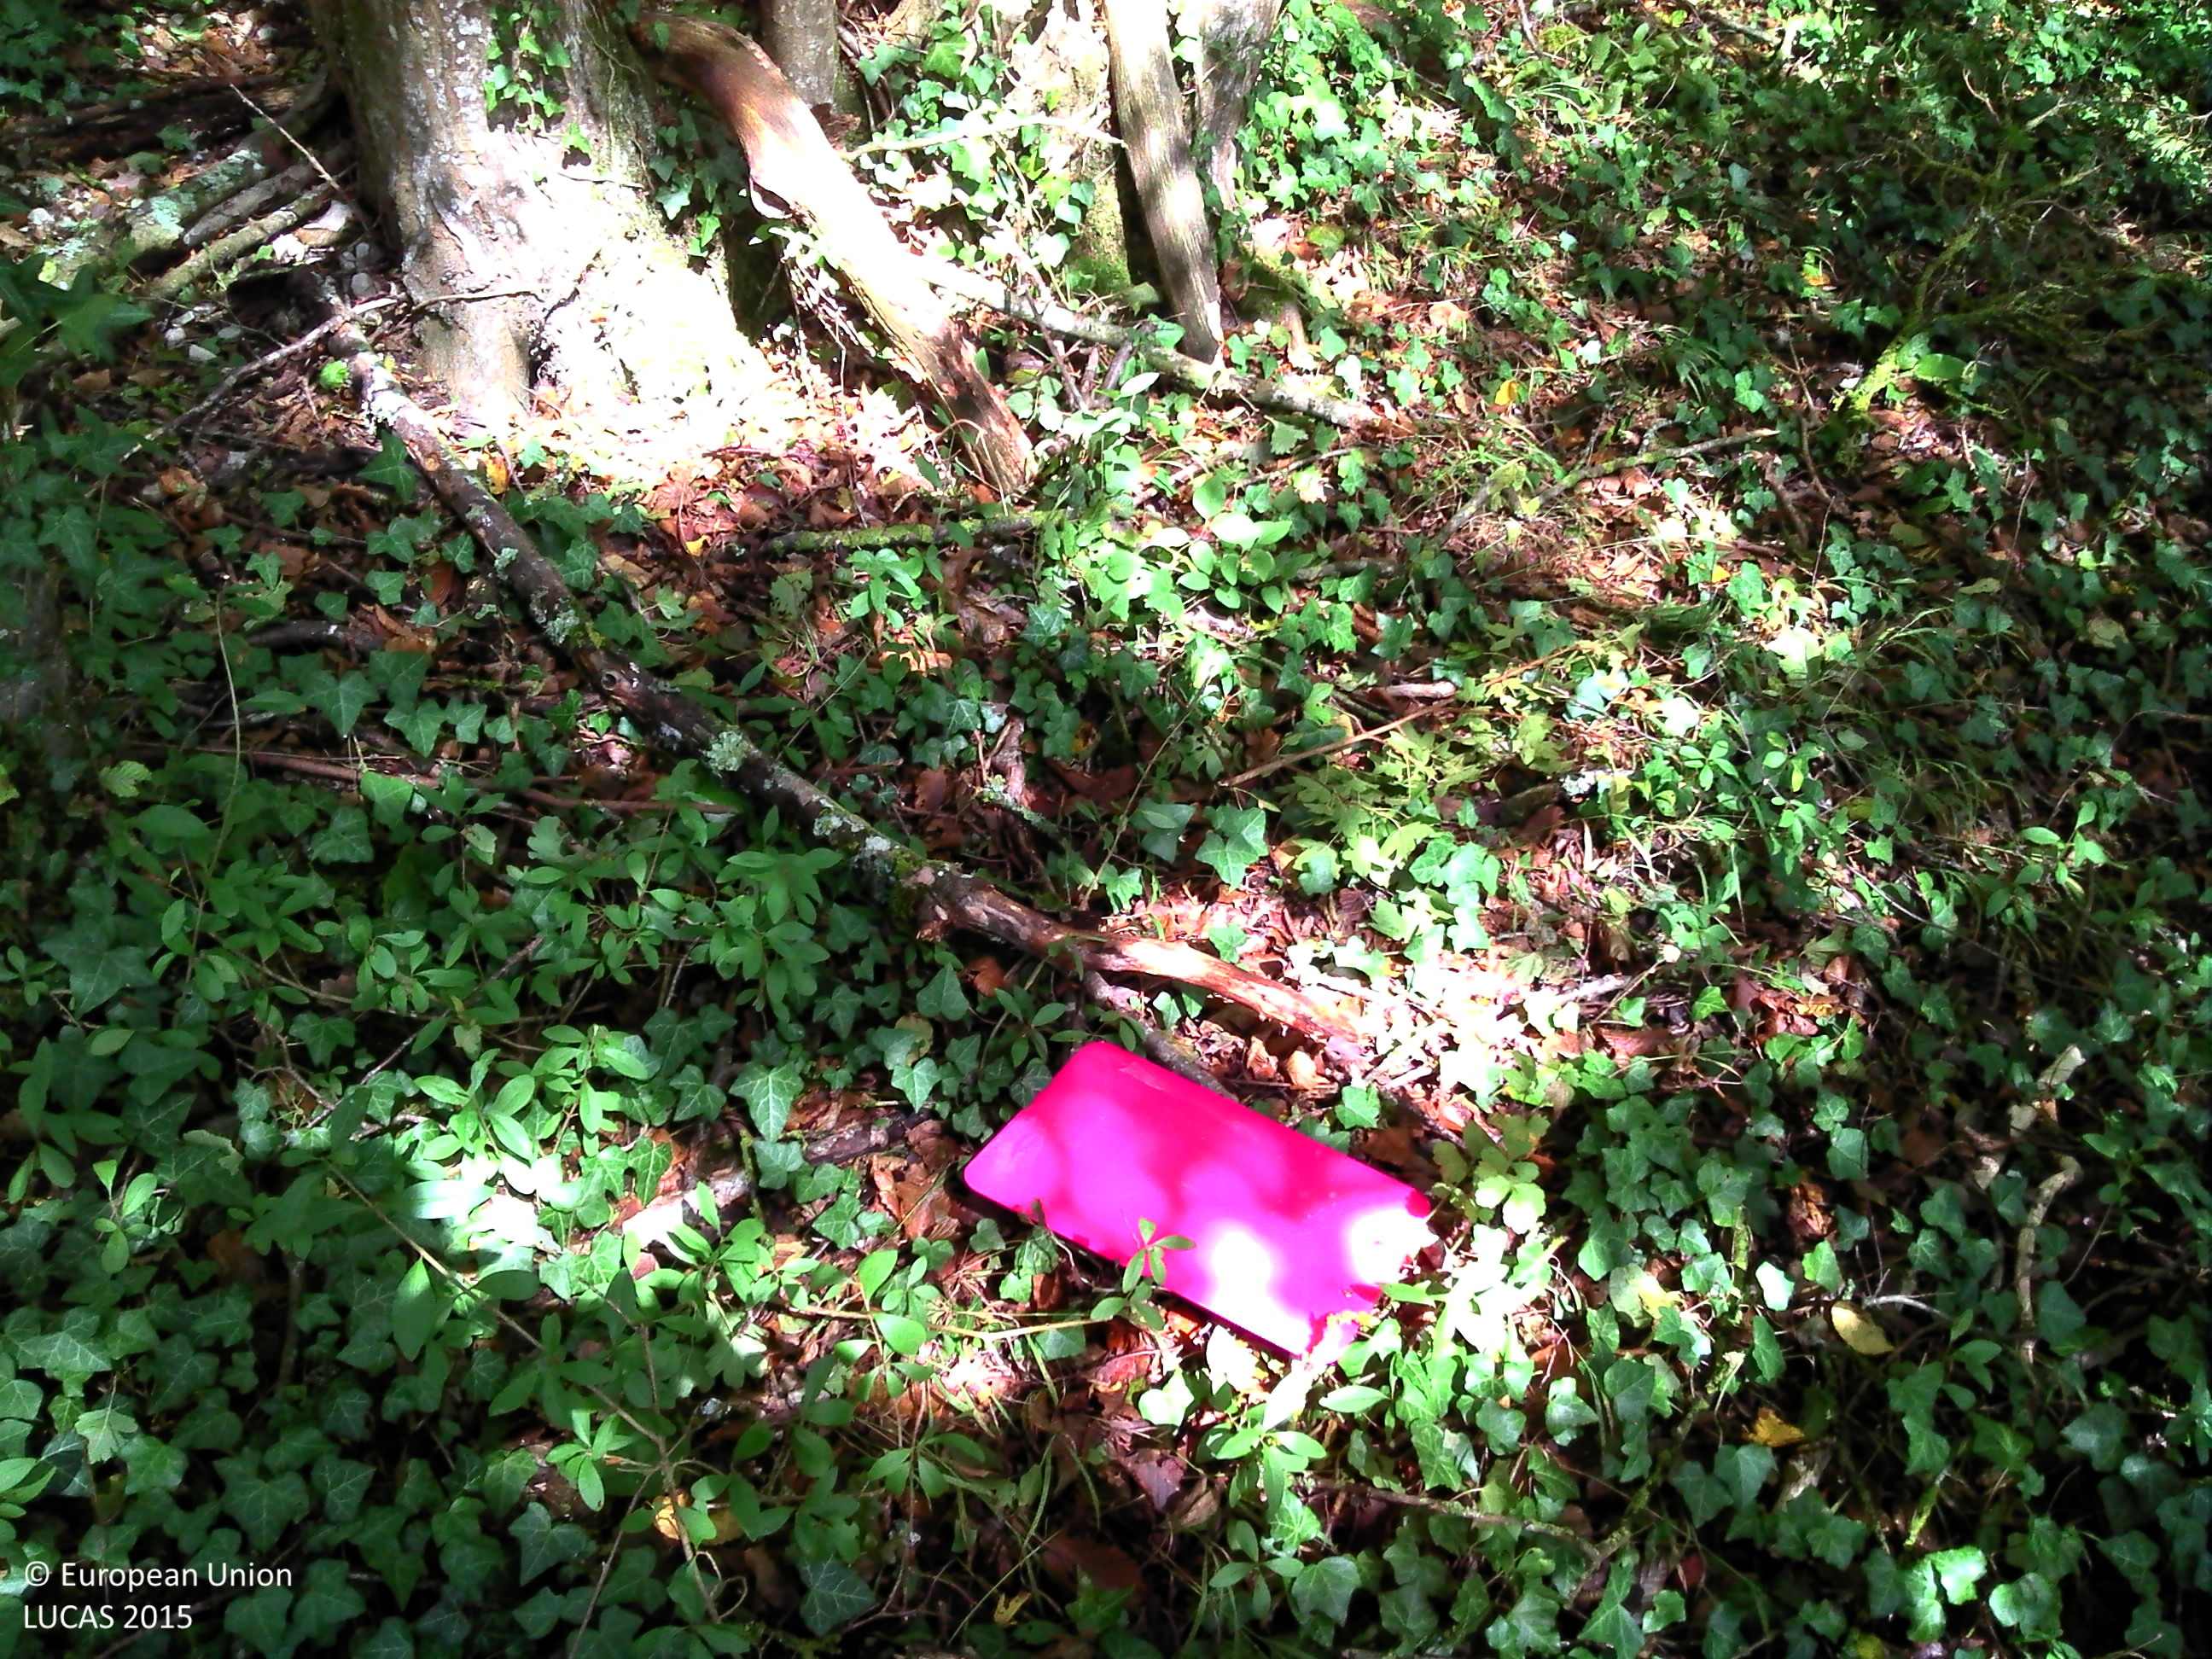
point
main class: Woodland
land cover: Broadleaved woodland
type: mesophytic deciduous forest
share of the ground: > 75 %
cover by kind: broadleaved forest trees 80 %, herbaceous plants 10 %, shrubs 5 %, lichens and mosses 5 %
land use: Forestry
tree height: > 5 m
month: September
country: FR
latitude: 48.2919
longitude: 4.6469
